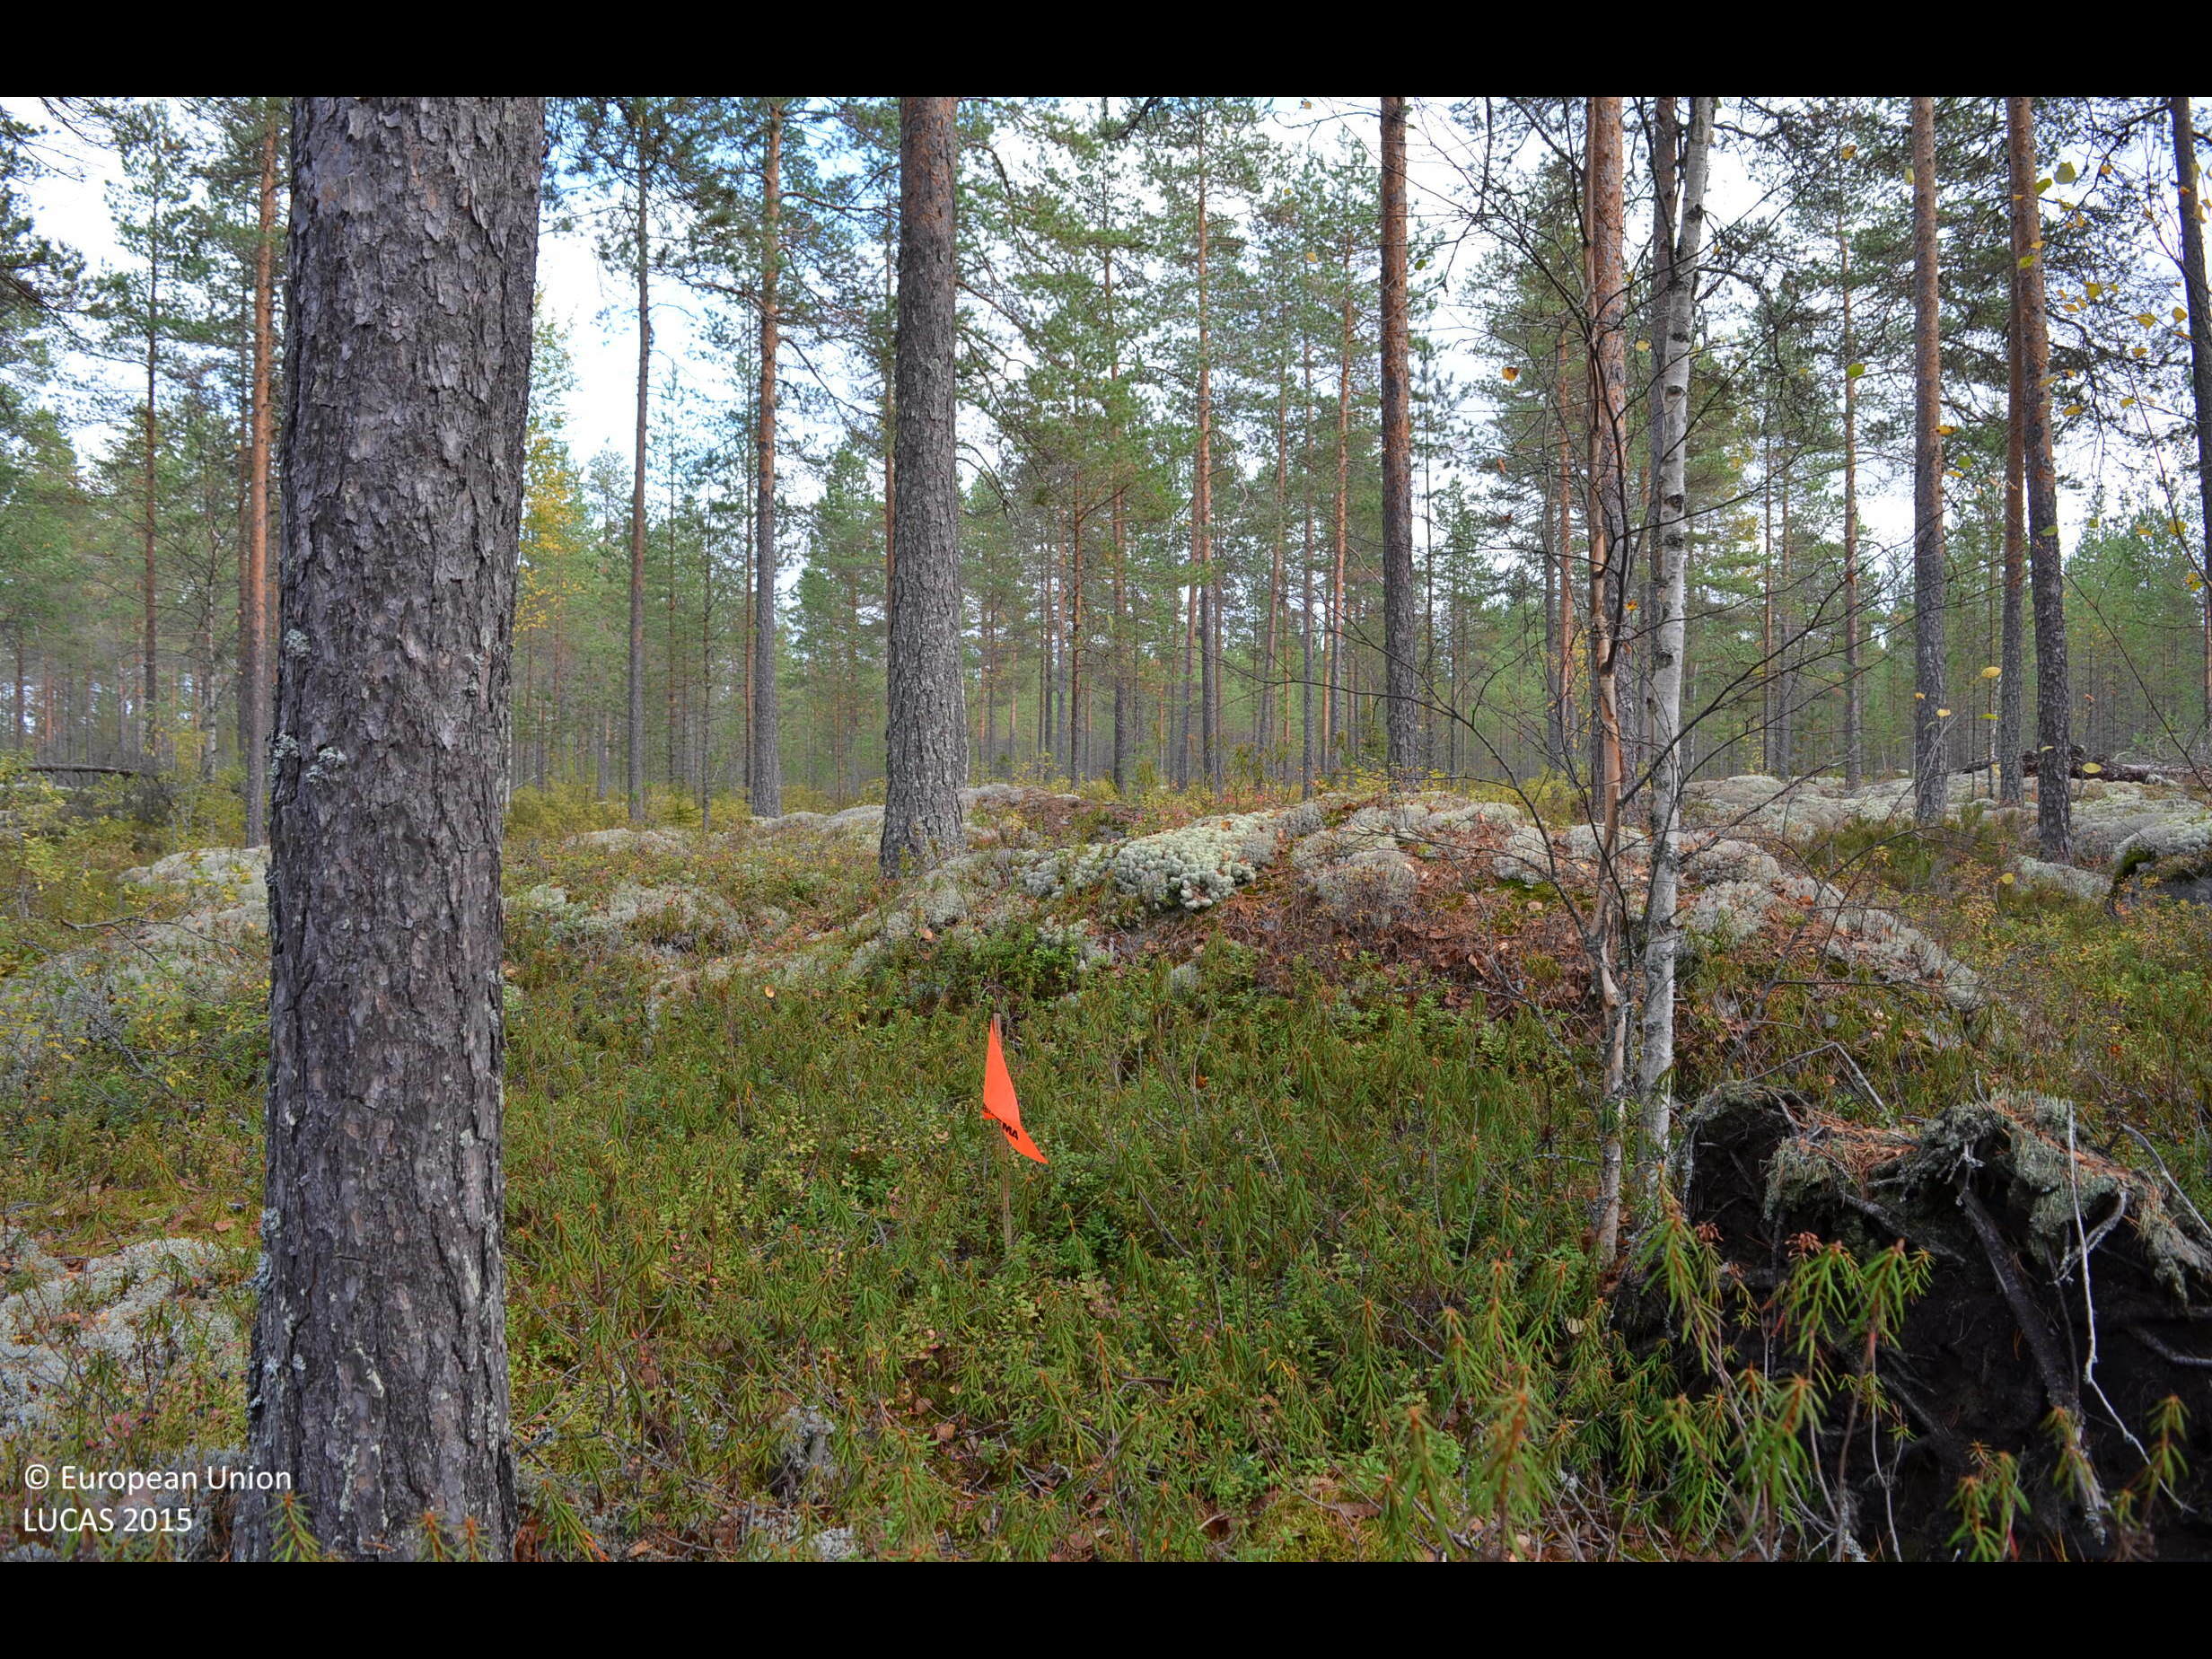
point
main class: Woodland
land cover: Pine dominated coniferous woodland
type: boreal forest
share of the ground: 50 - 75 %
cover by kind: coniferous forest trees 55 %, shrubs 25 %, unconsolidated bare surface 15 %, broadleaved forest trees 5 %
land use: Forestry
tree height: > 5 m
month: September
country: FI
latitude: 62.5259
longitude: 23.5756
